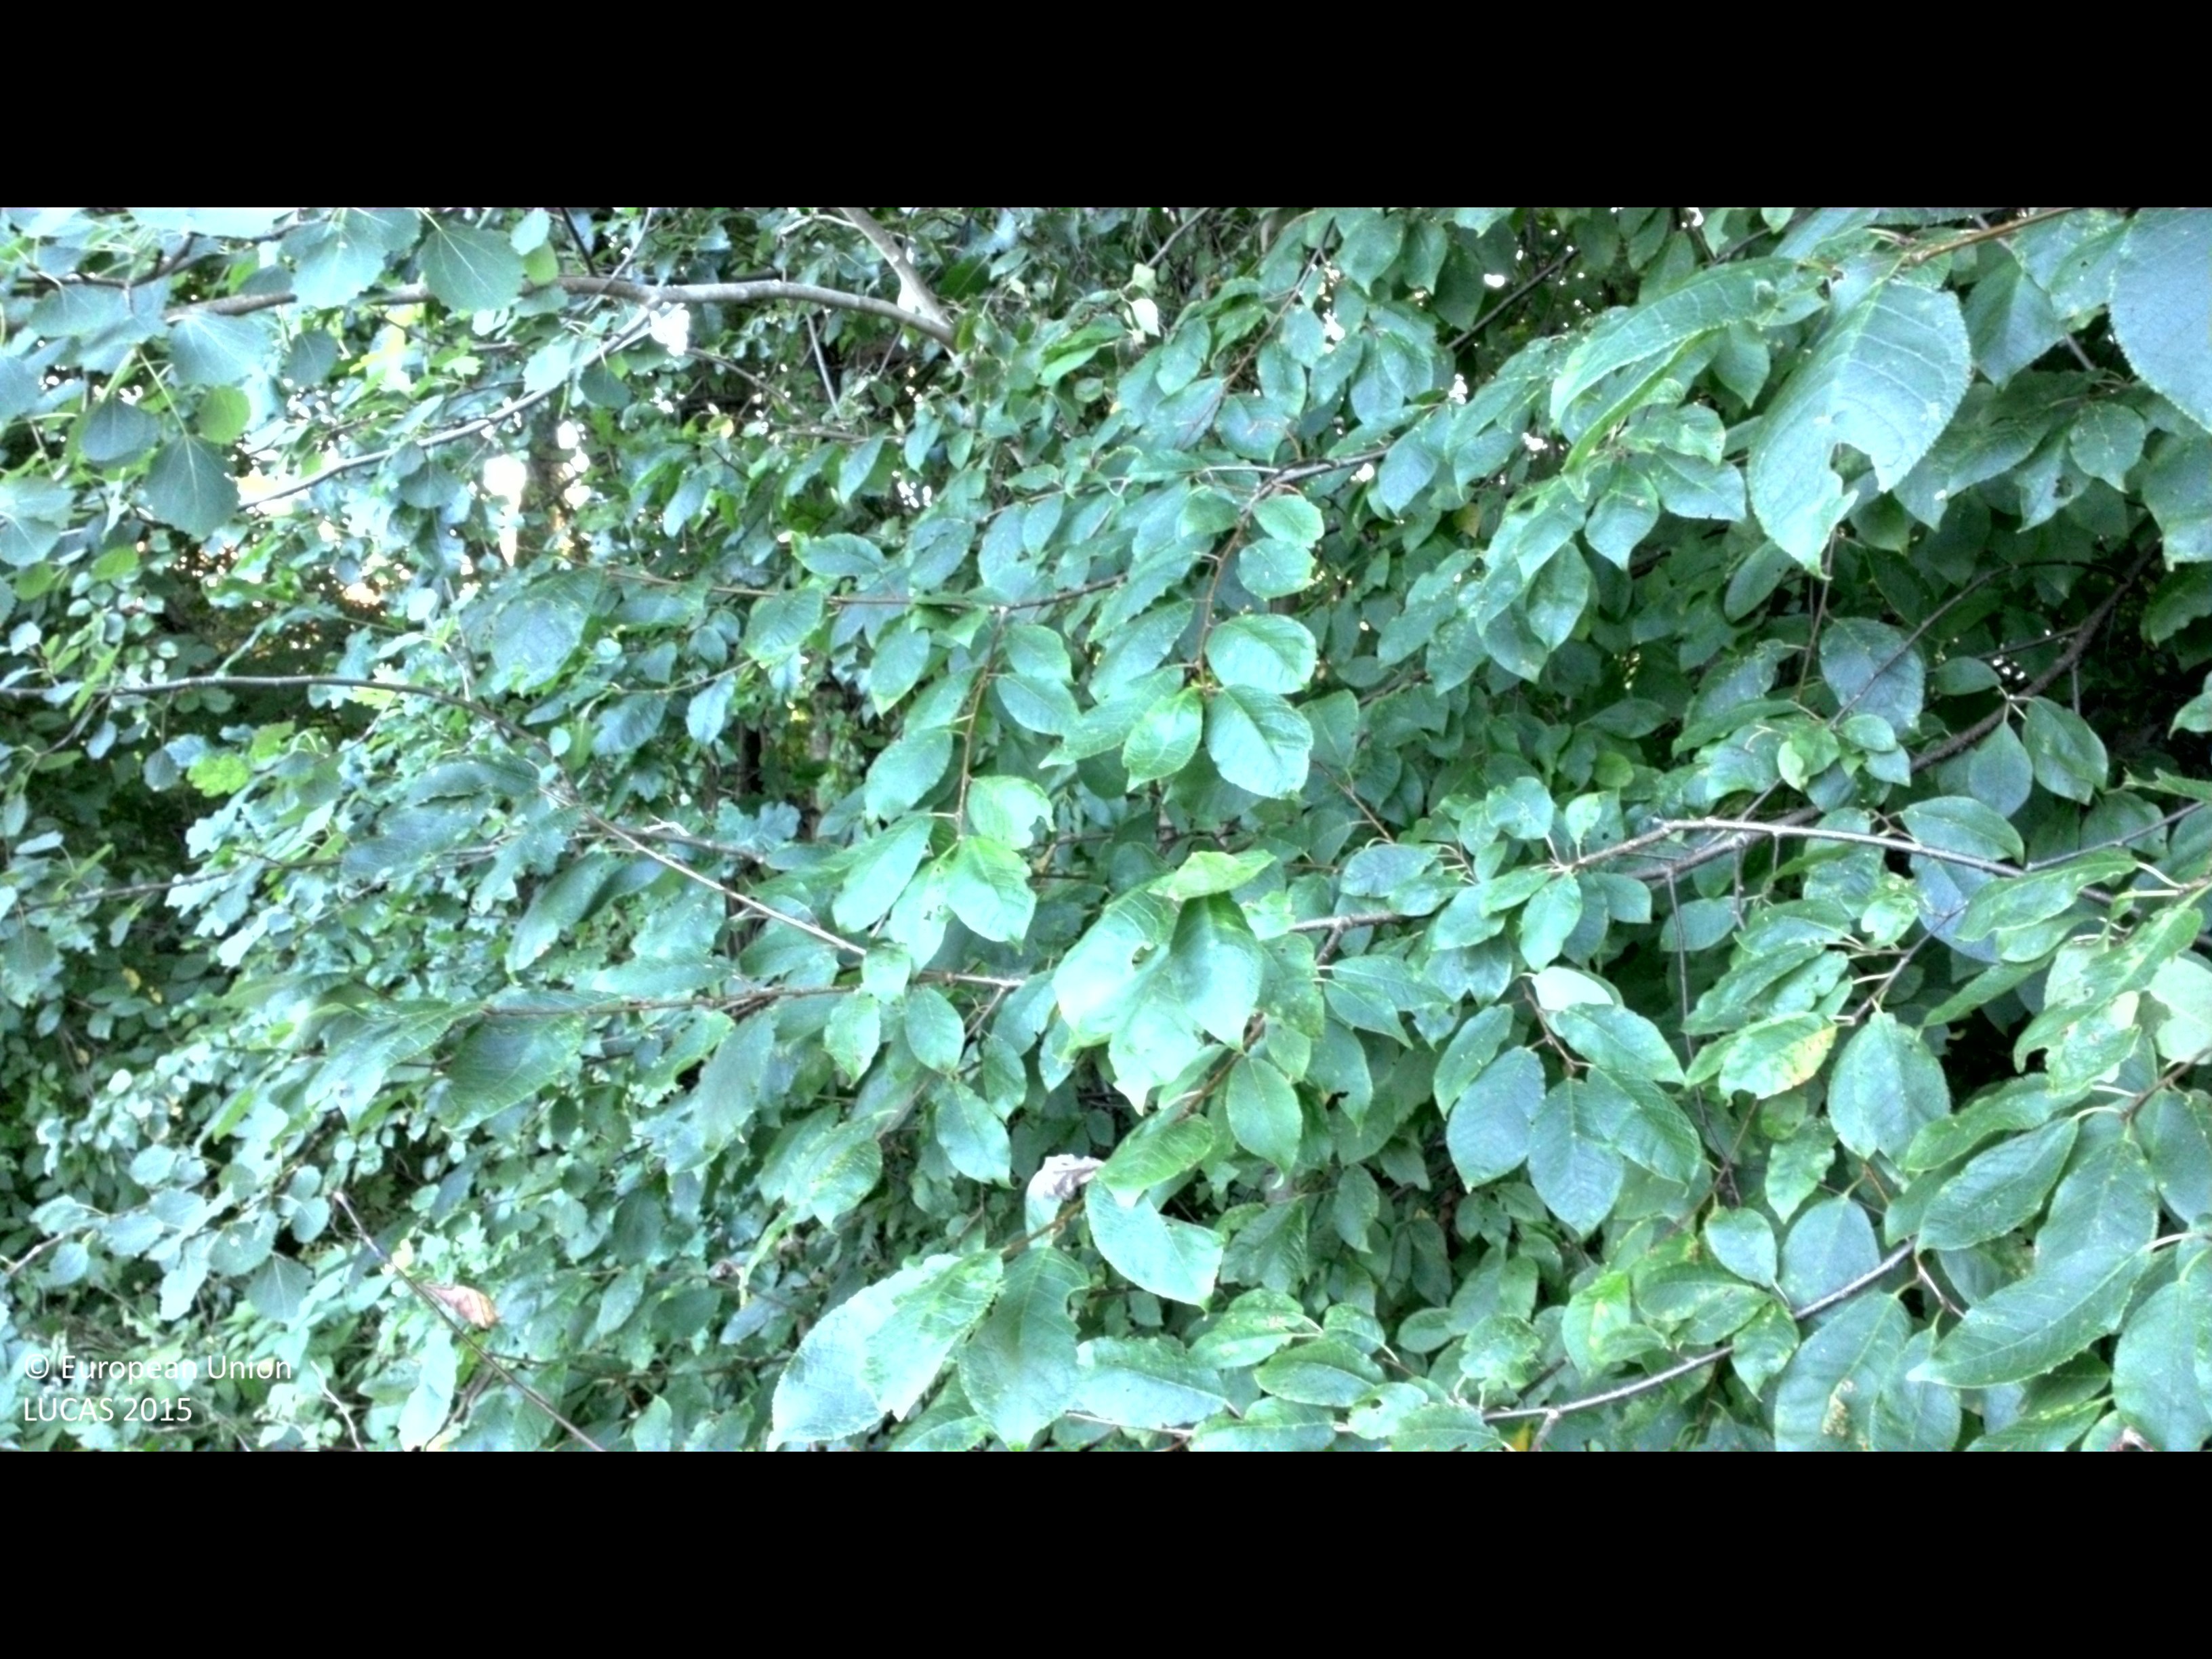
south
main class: Woodland
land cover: Broadleaved woodland
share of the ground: 50 - 75 %
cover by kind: broadleaved forest trees 60 %, shrubs 40 %
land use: Semi-natural and natural areas not in use
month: August
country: SE
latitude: 57.0106
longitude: 13.2404
